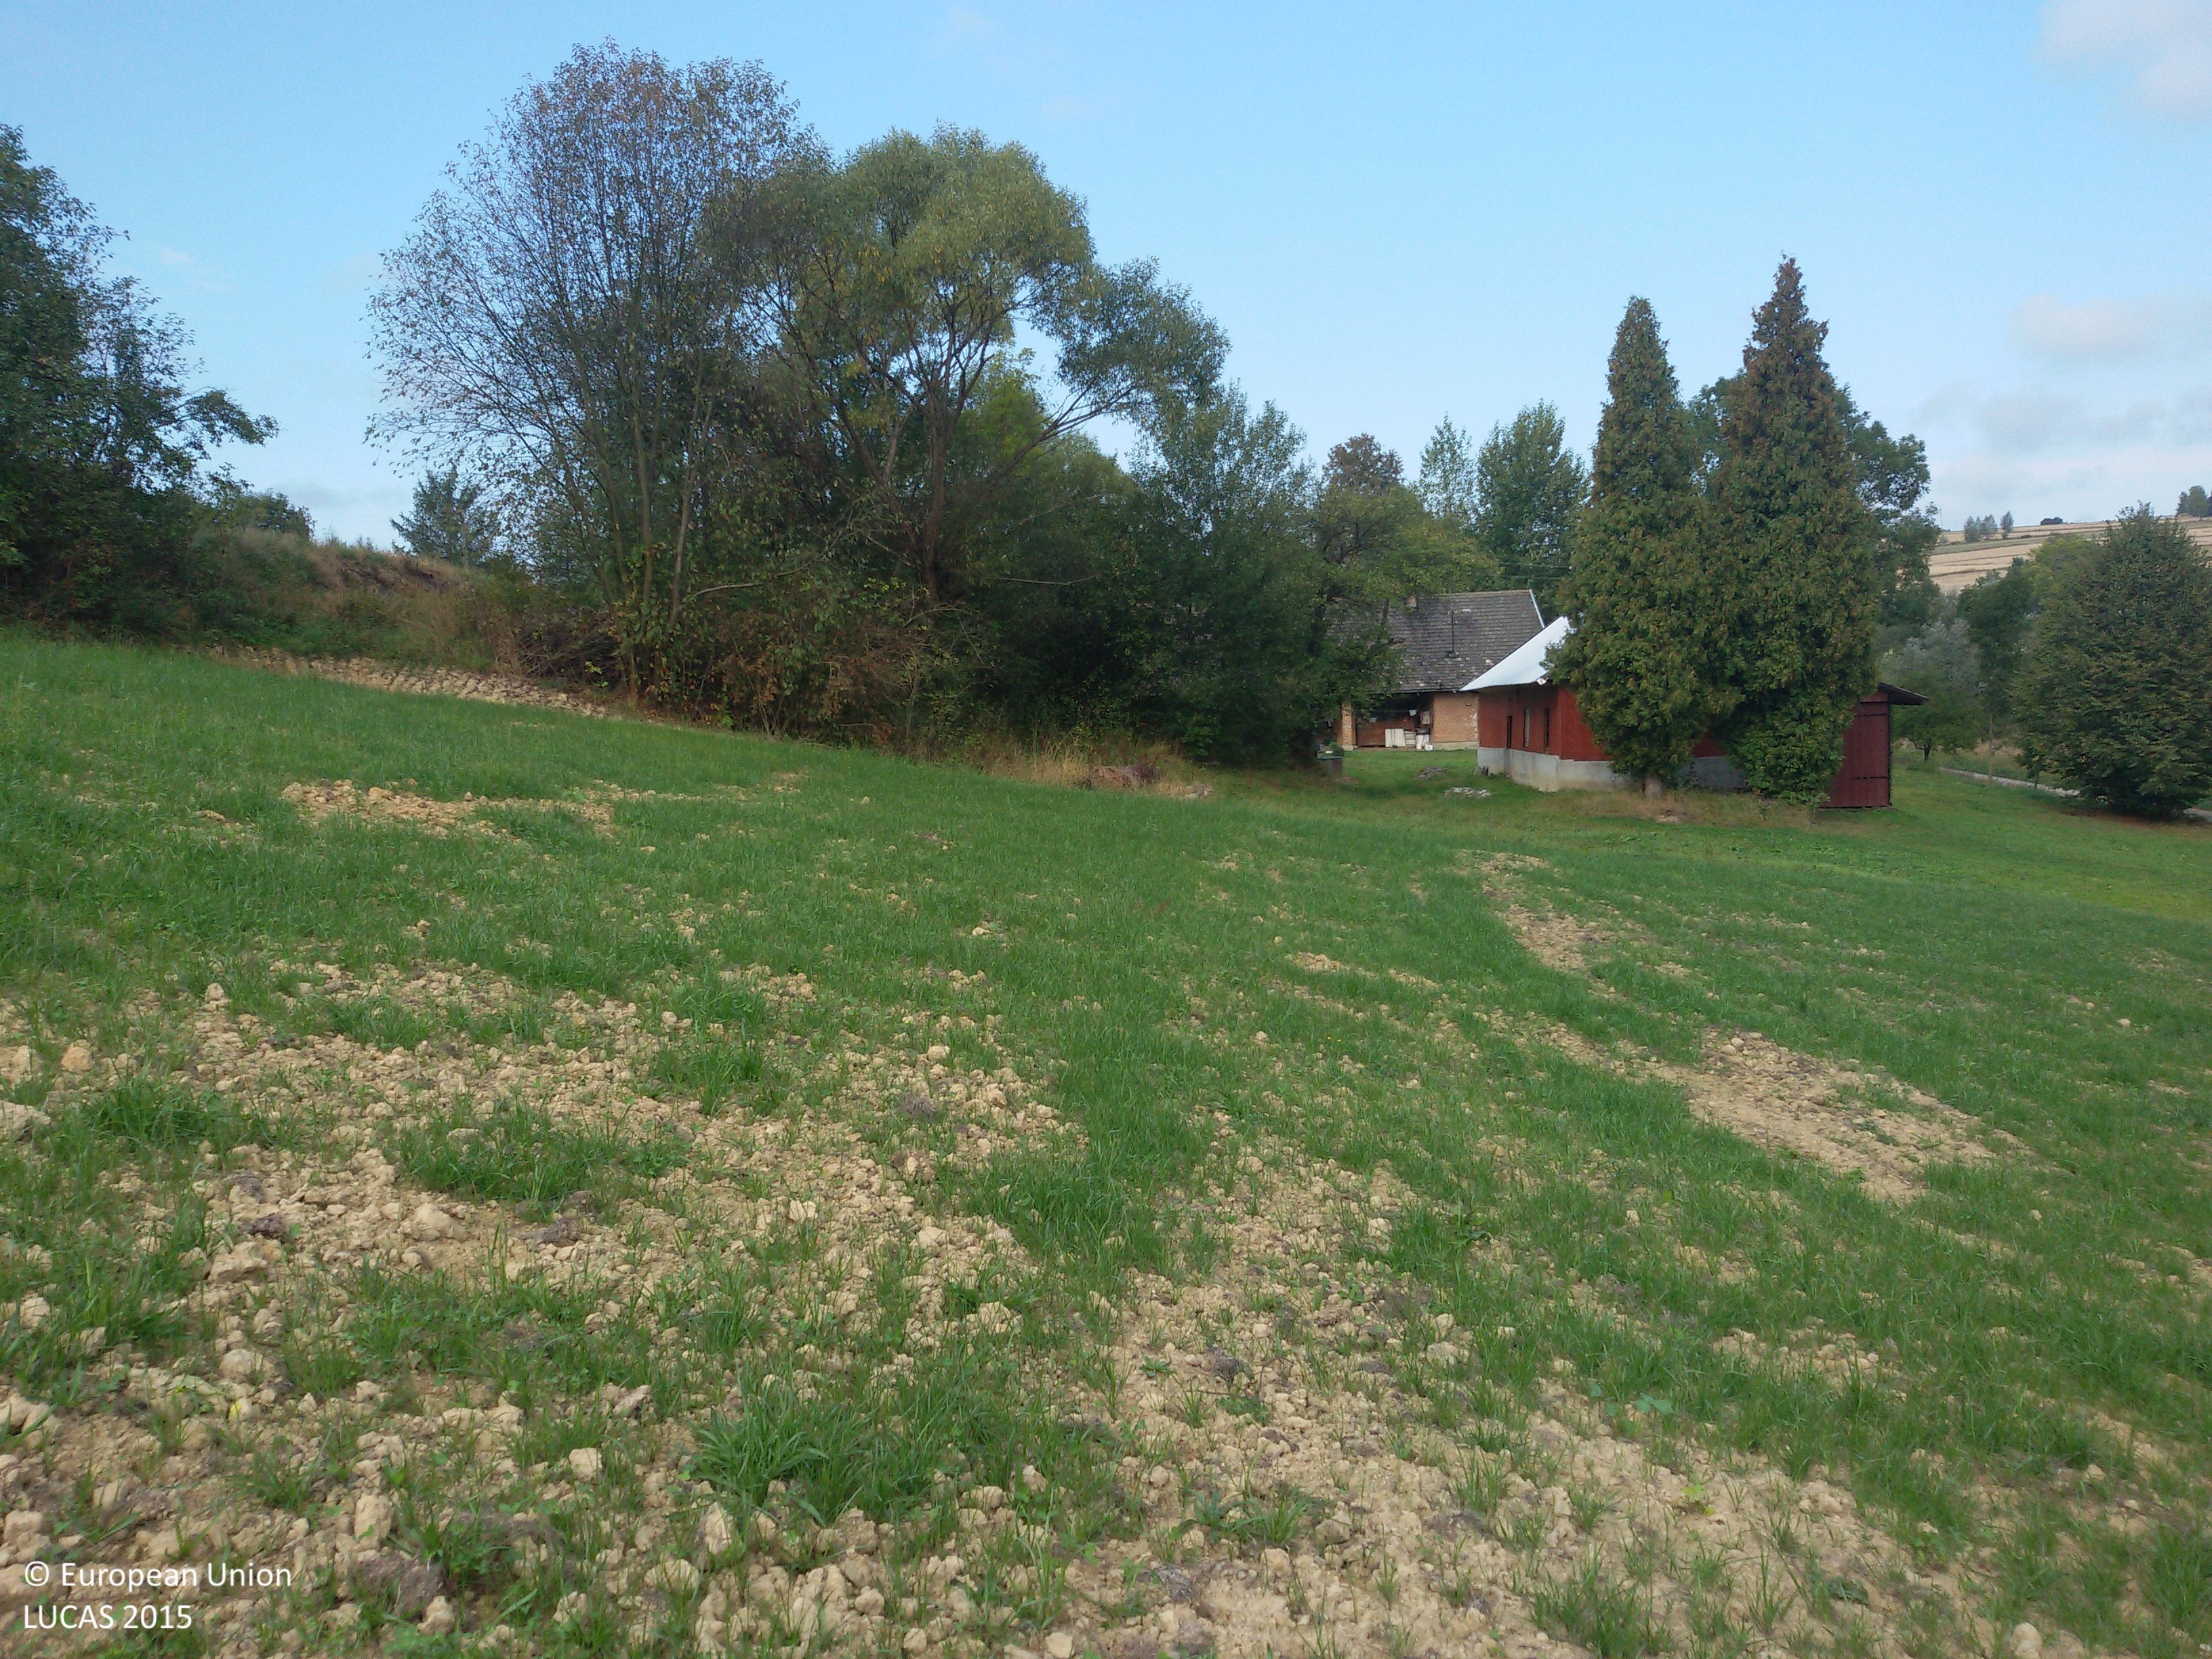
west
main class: Cropland
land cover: Rye
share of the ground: 50 - 75 %
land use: Agriculture (excluding fallow land and kitchen gardens)
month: September
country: PL
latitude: 49.7556
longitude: 21.2200
